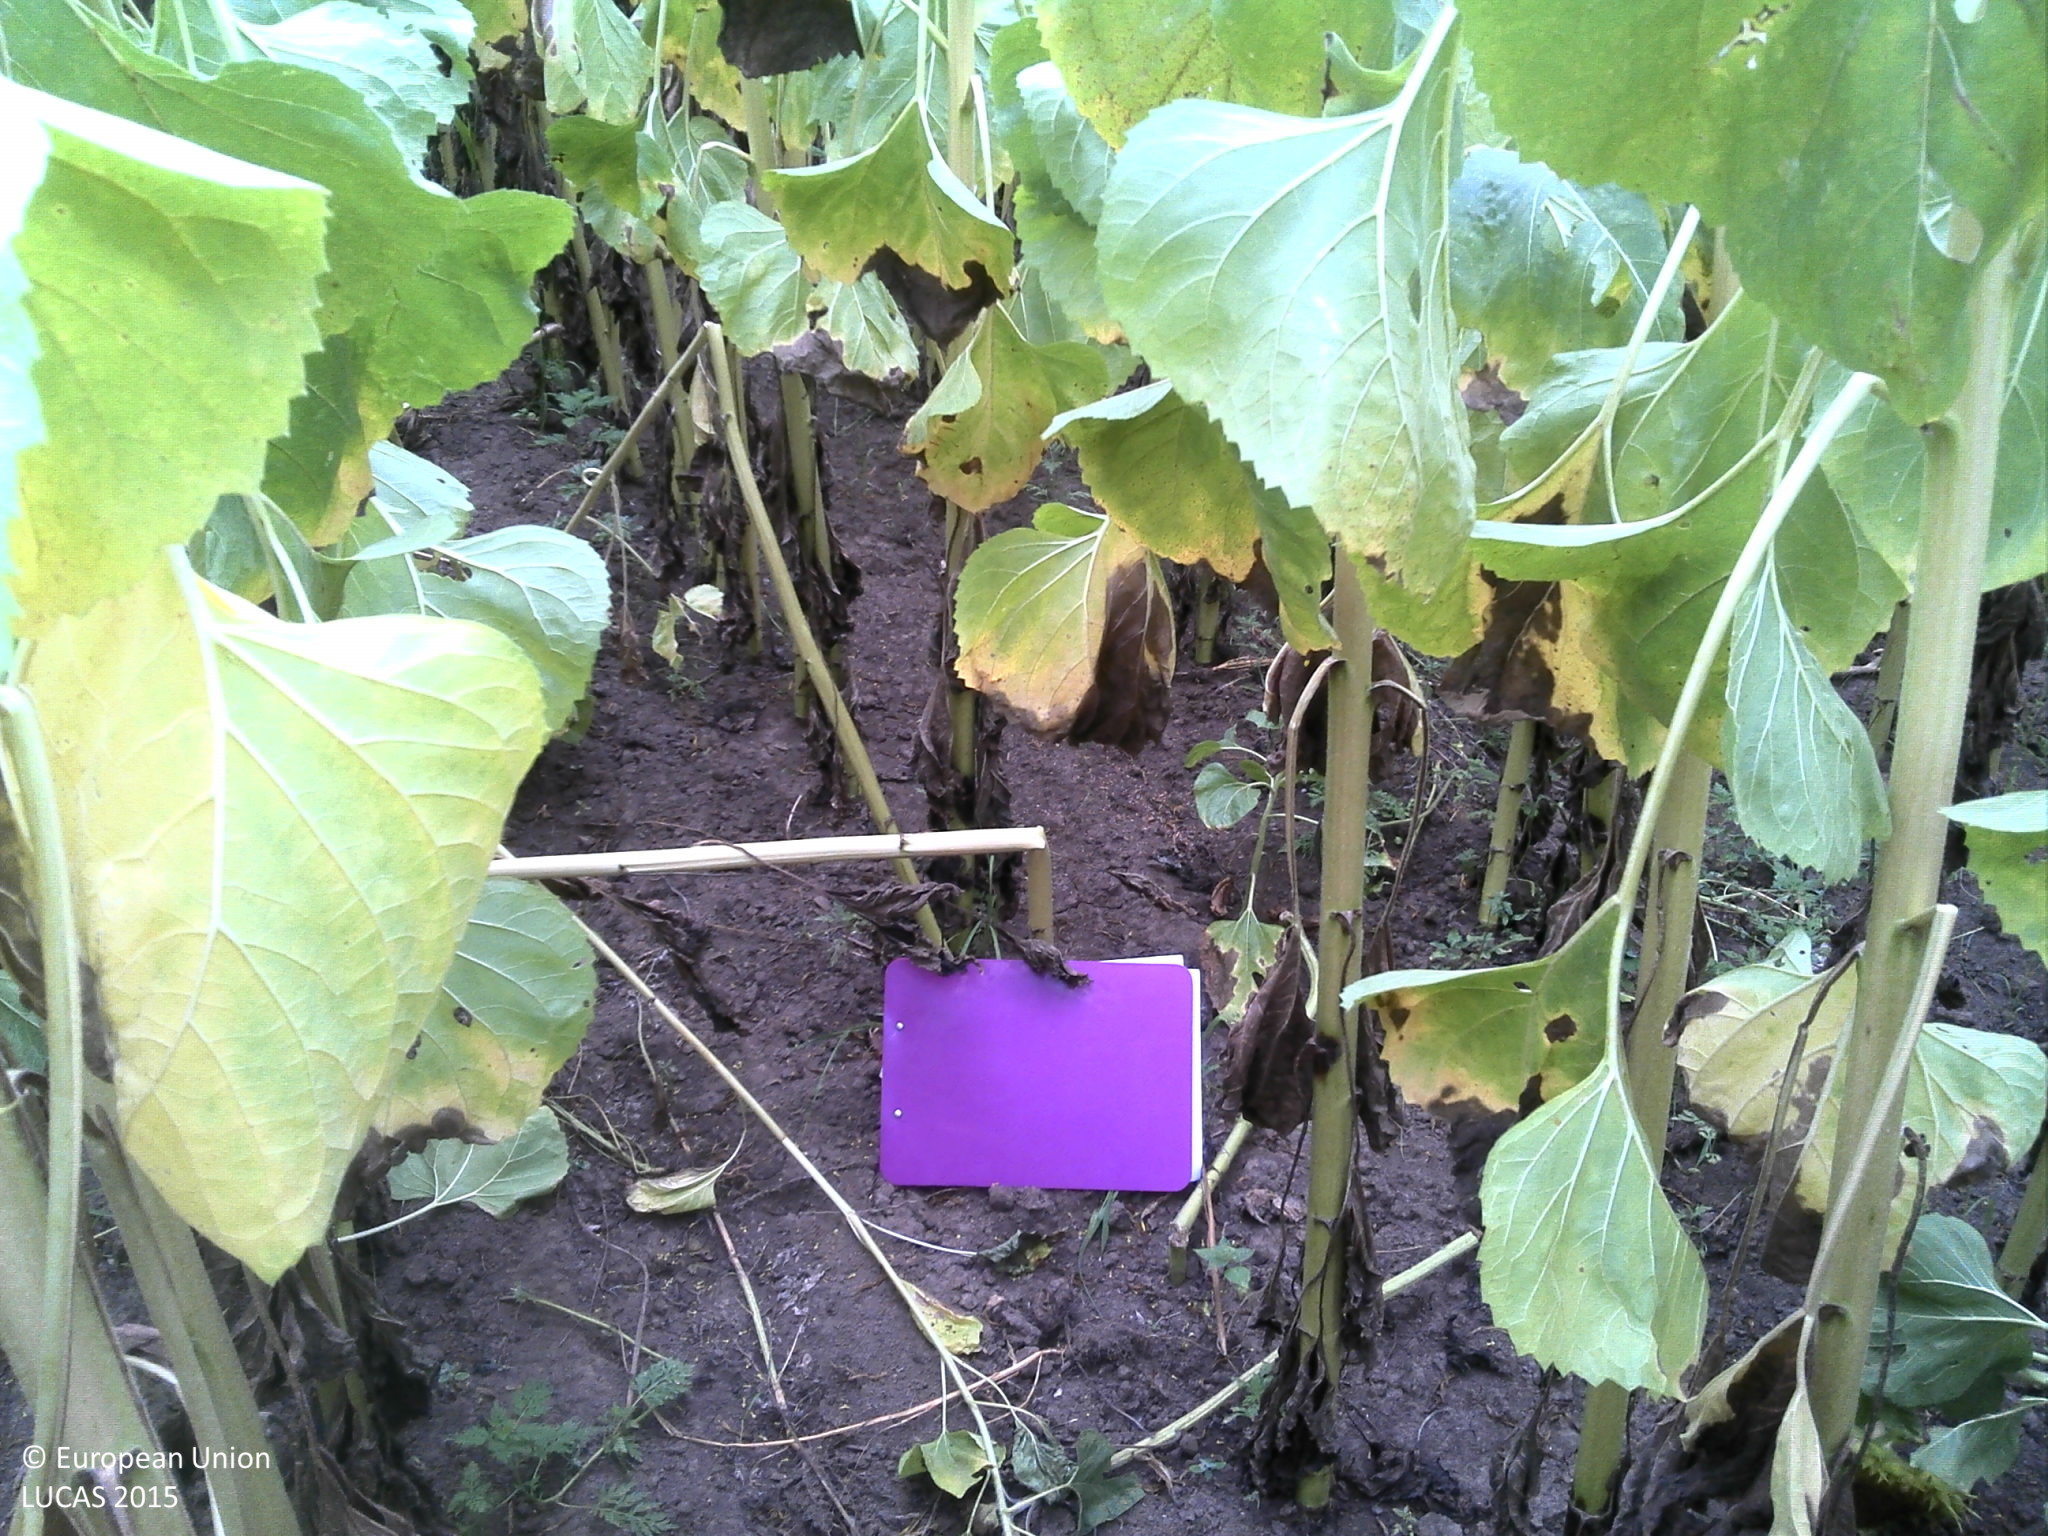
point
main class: Cropland
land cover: Sunflower
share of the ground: > 75 %
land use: Agriculture (excluding fallow land and kitchen gardens)
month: July
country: HR
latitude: 45.8574
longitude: 18.6249
